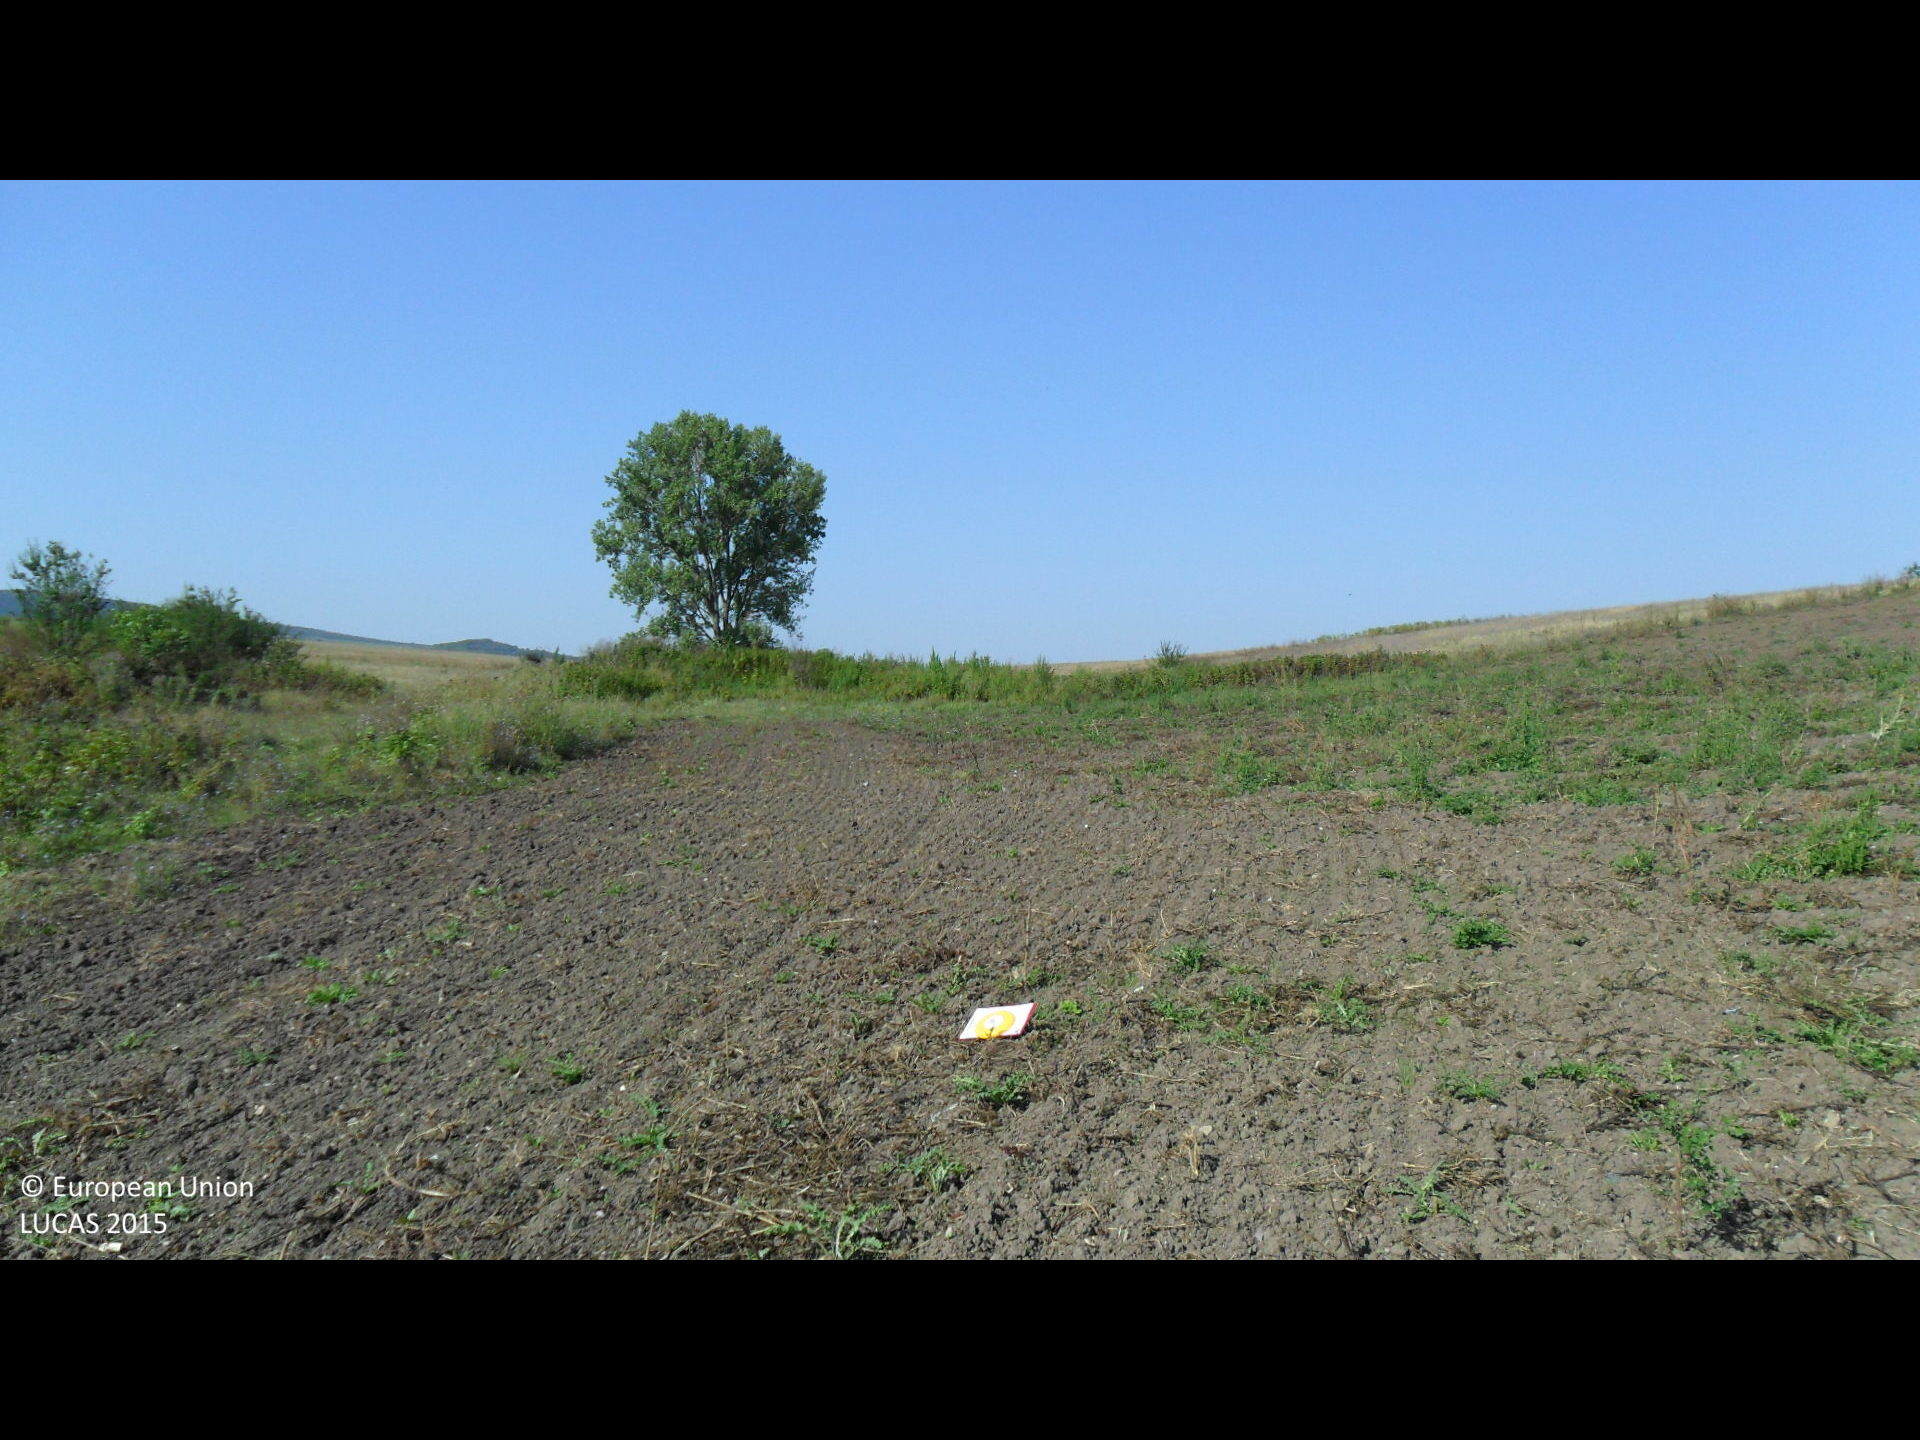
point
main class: Grassland
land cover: Spontaneously vegetated surfaces
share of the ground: 50 - 75 %
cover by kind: herbaceous plants 75 %, consolidated bare surface 25 %
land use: Fallow land
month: August
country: BG
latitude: 43.3321
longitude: 26.4935
